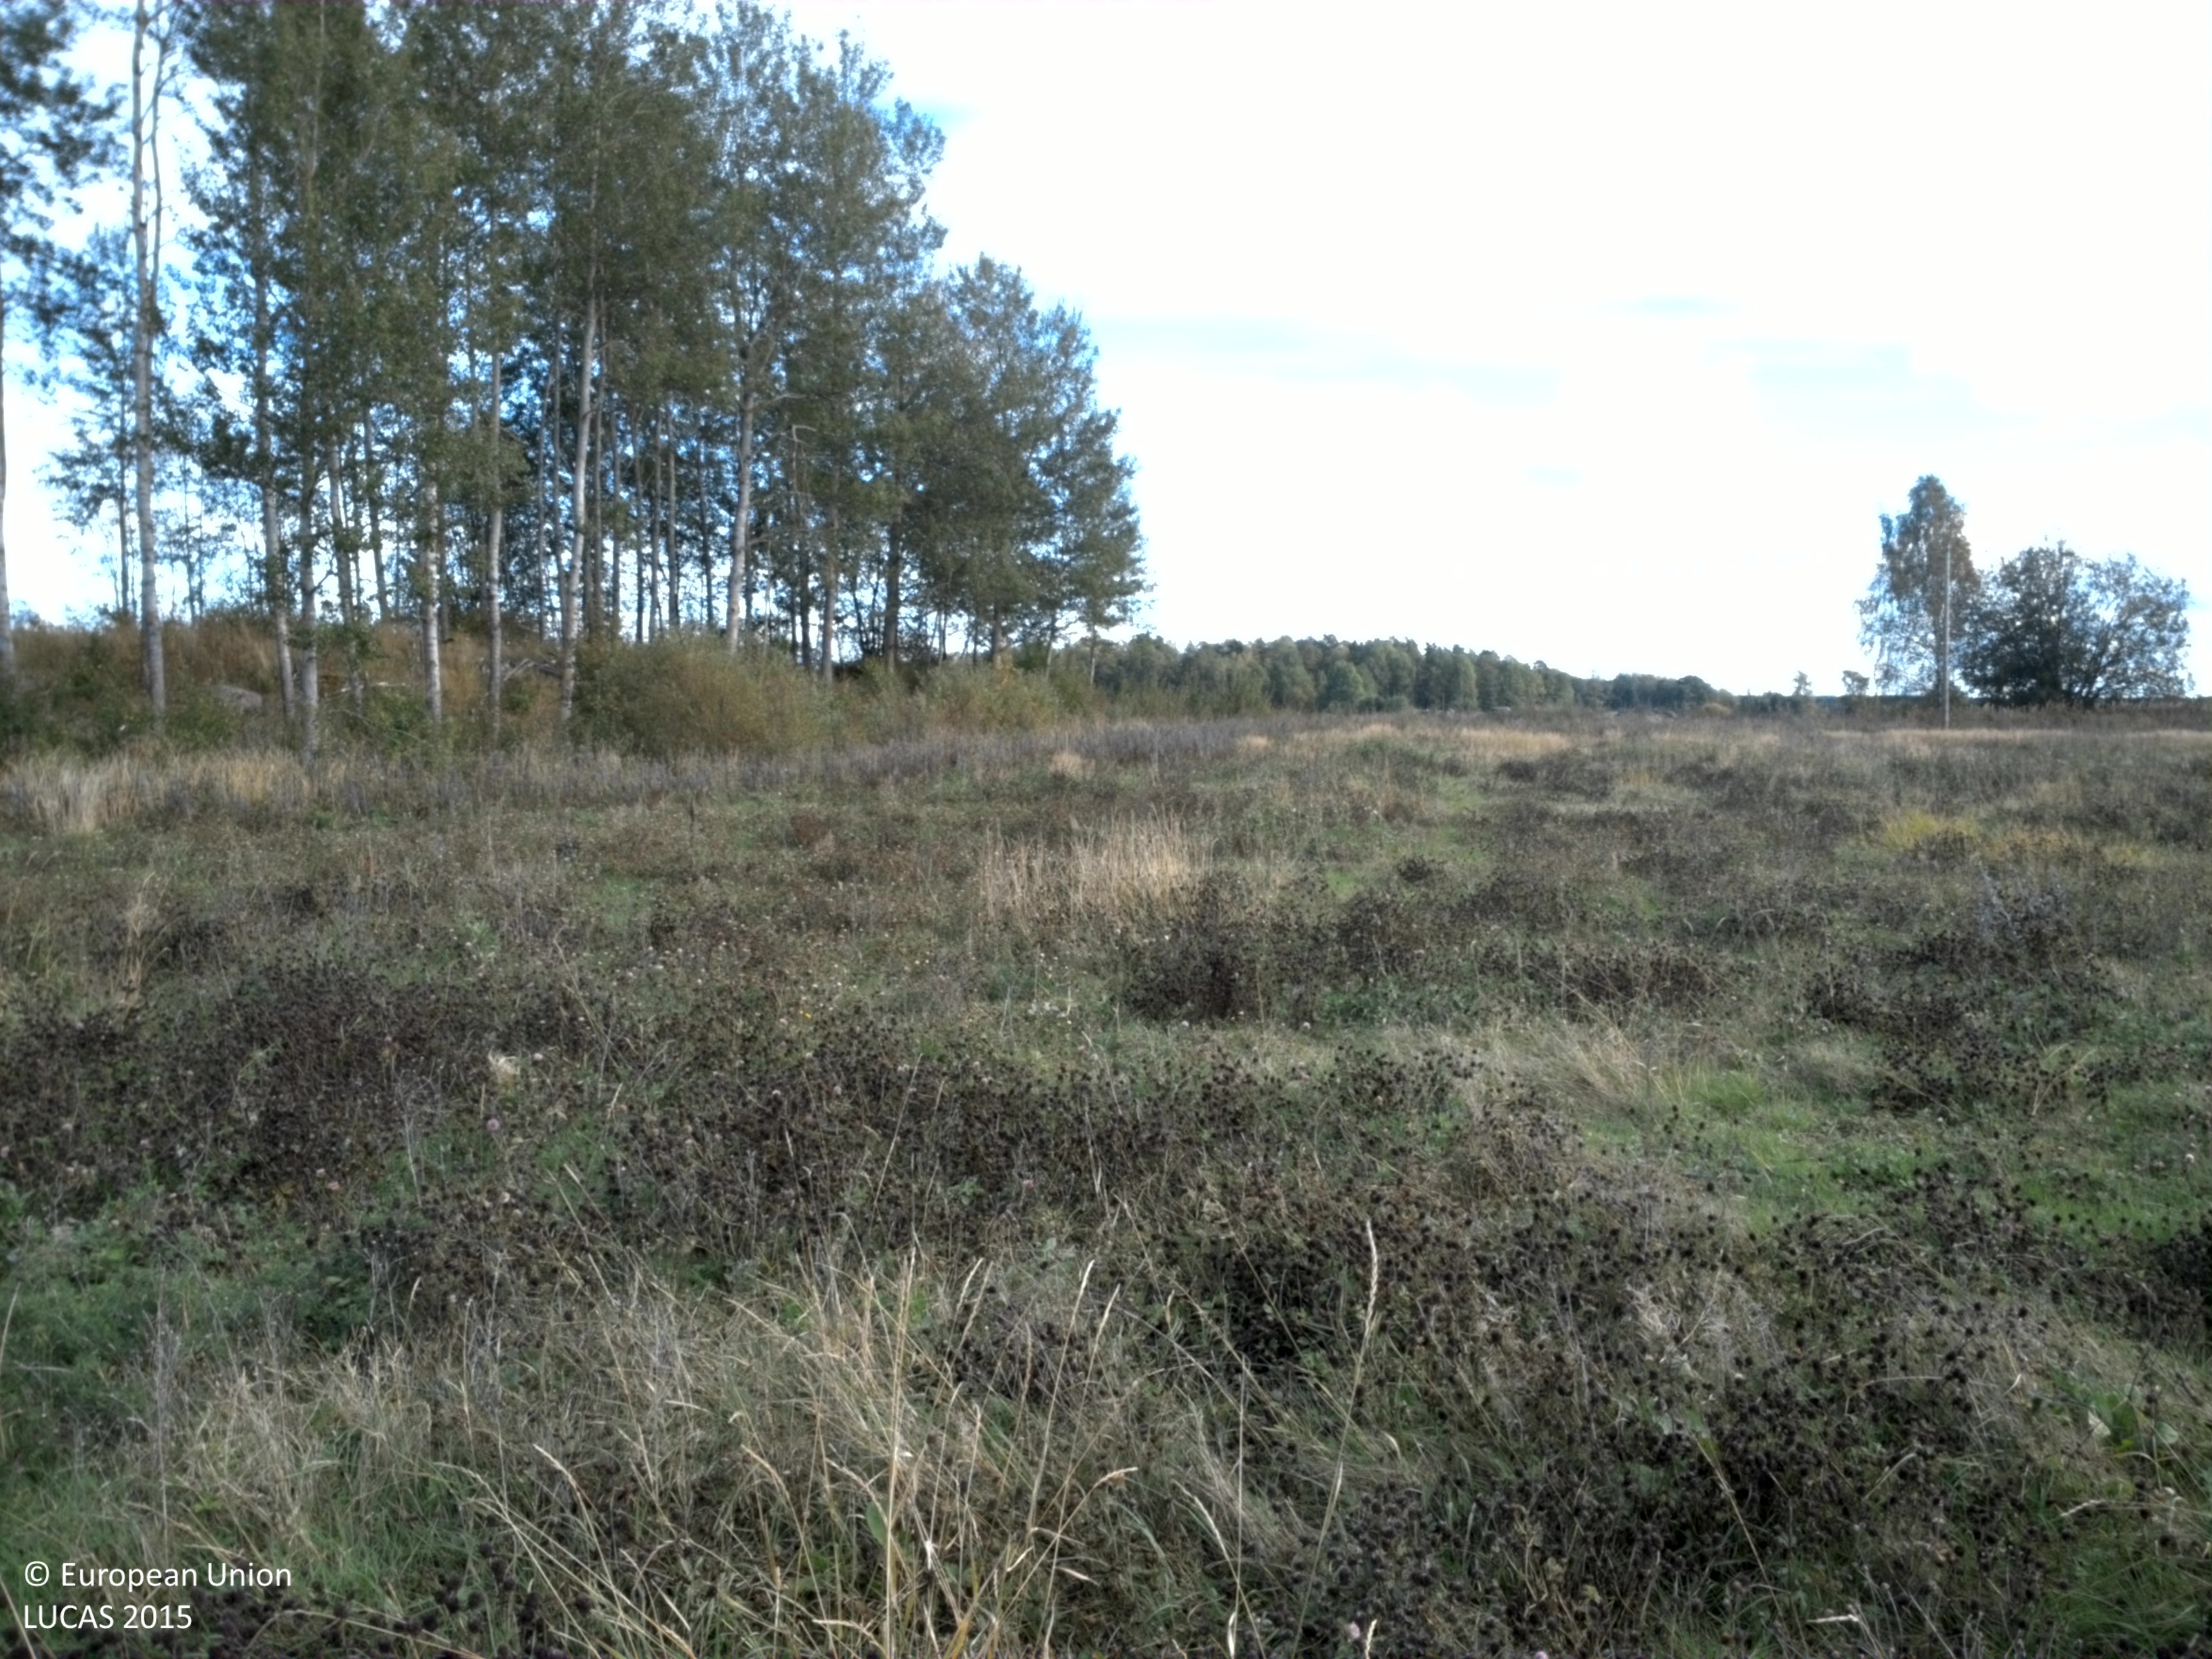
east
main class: Grassland
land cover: Spontaneously vegetated surfaces
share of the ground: > 75 %
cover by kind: herbaceous plants 100 %
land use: Fallow land
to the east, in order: Spontaneously vegetated surfaces; Ditches and canals; Broadleaved woodland; Electric lines; Grass margins; Paved roads, cycling and walking lanes; Ditches and canals; Shruby margins; Grassland without tree/shrub cover
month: September
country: SE
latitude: 59.0929
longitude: 14.1289
